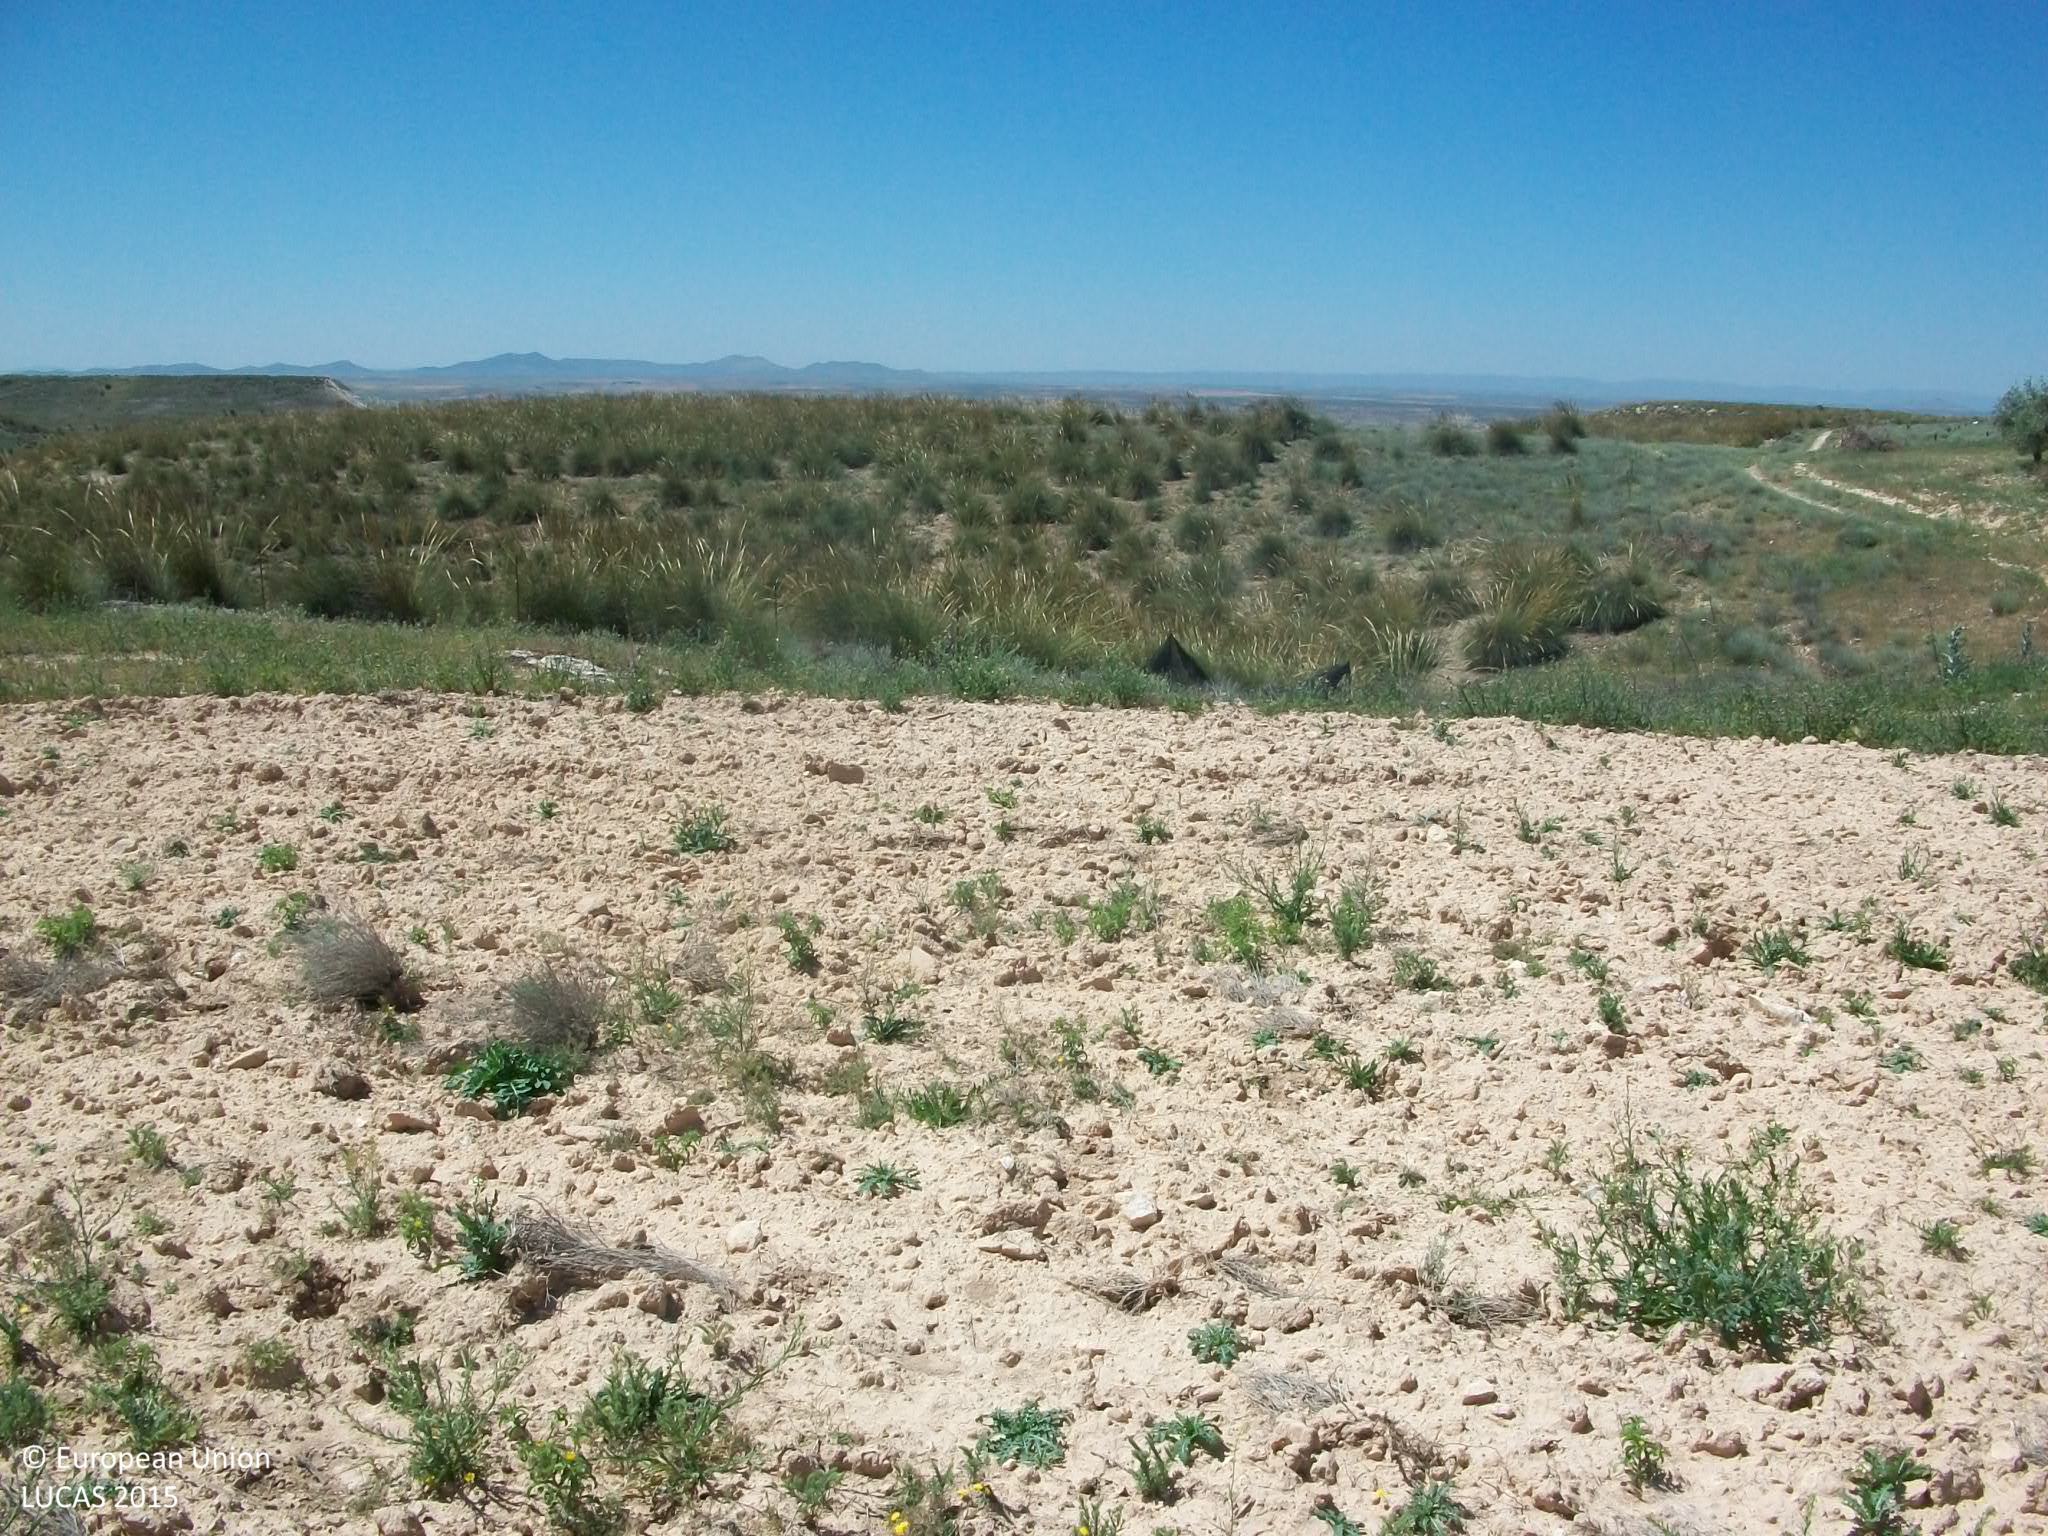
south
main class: Grassland
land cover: Spontaneously vegetated surfaces
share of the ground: 25 - 50 %
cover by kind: unconsolidated bare surface 70 %, herbaceous plants 30 %
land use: Fallow land
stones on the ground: 10 - 25 %
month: May
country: ES
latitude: 39.8794
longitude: -3.6281
